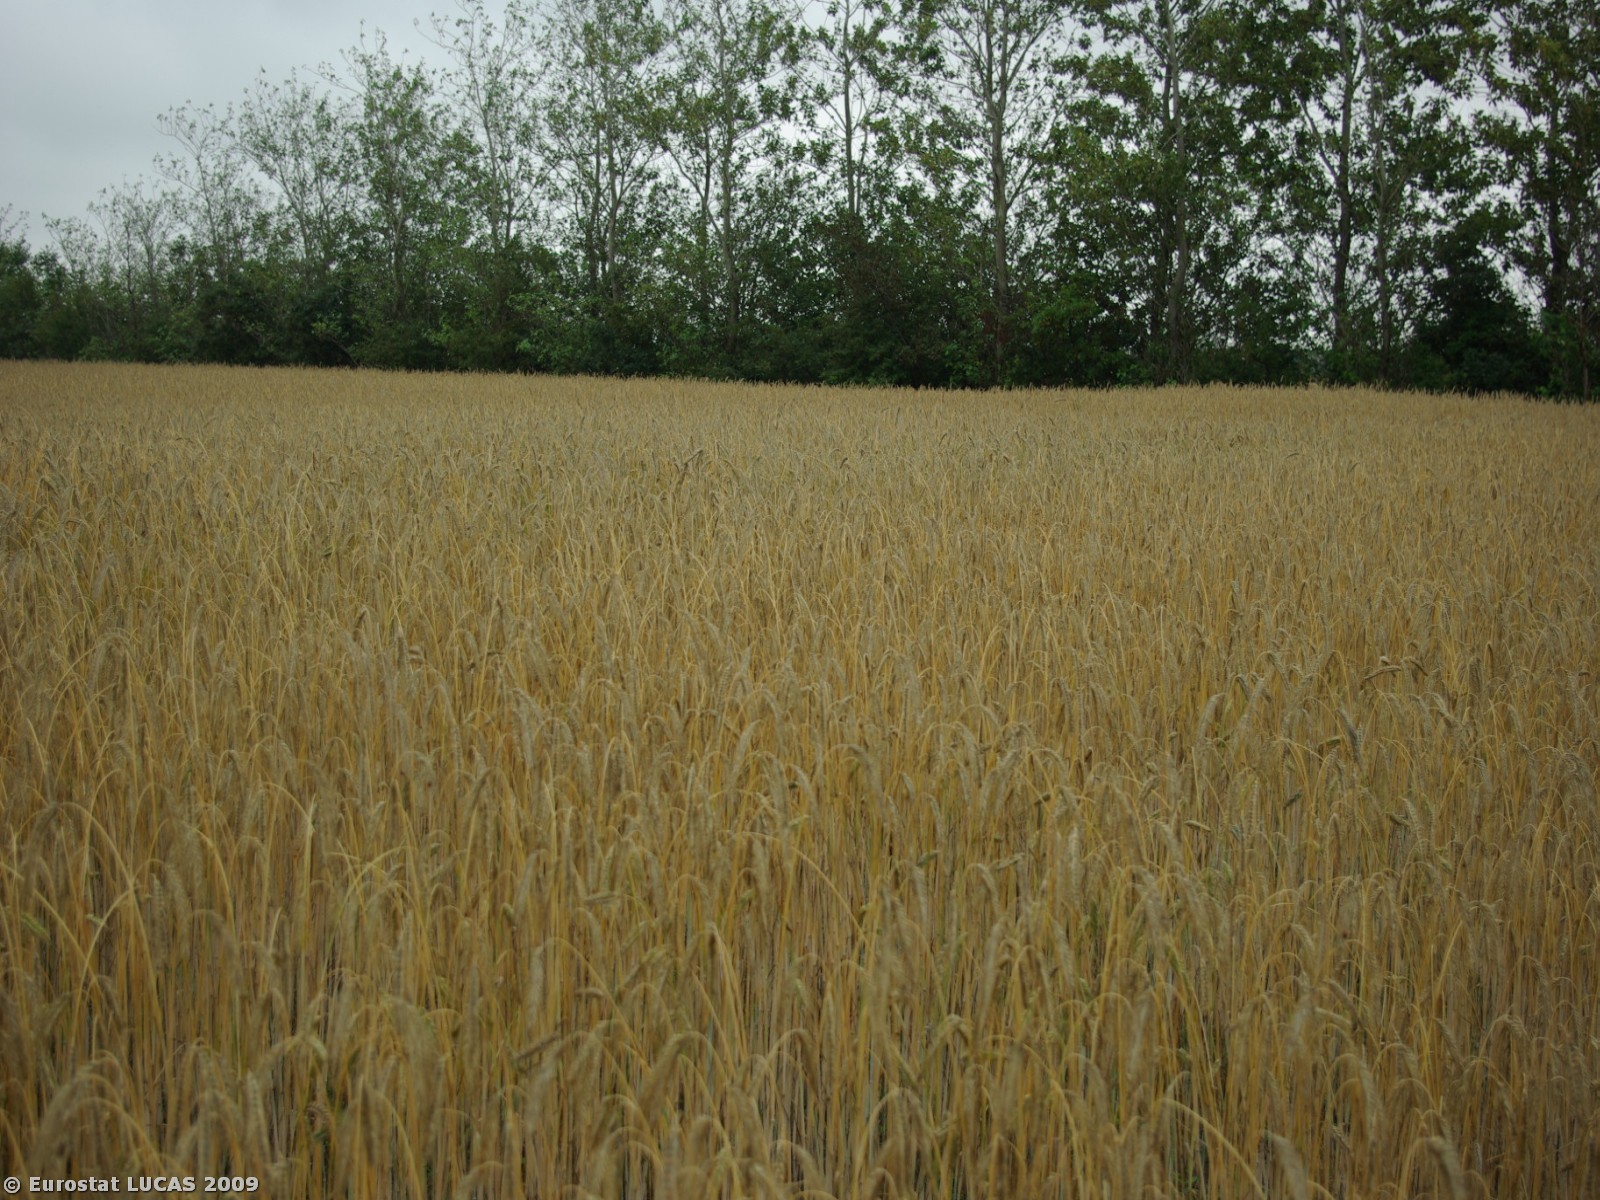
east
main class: Cropland
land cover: Rye
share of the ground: > 75 %
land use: Agriculture (excluding fallow land and kitchen gardens)
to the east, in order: Rye; Broadleaved woodland; Rye; Oats
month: July
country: DK
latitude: 55.0669
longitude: 8.7326
